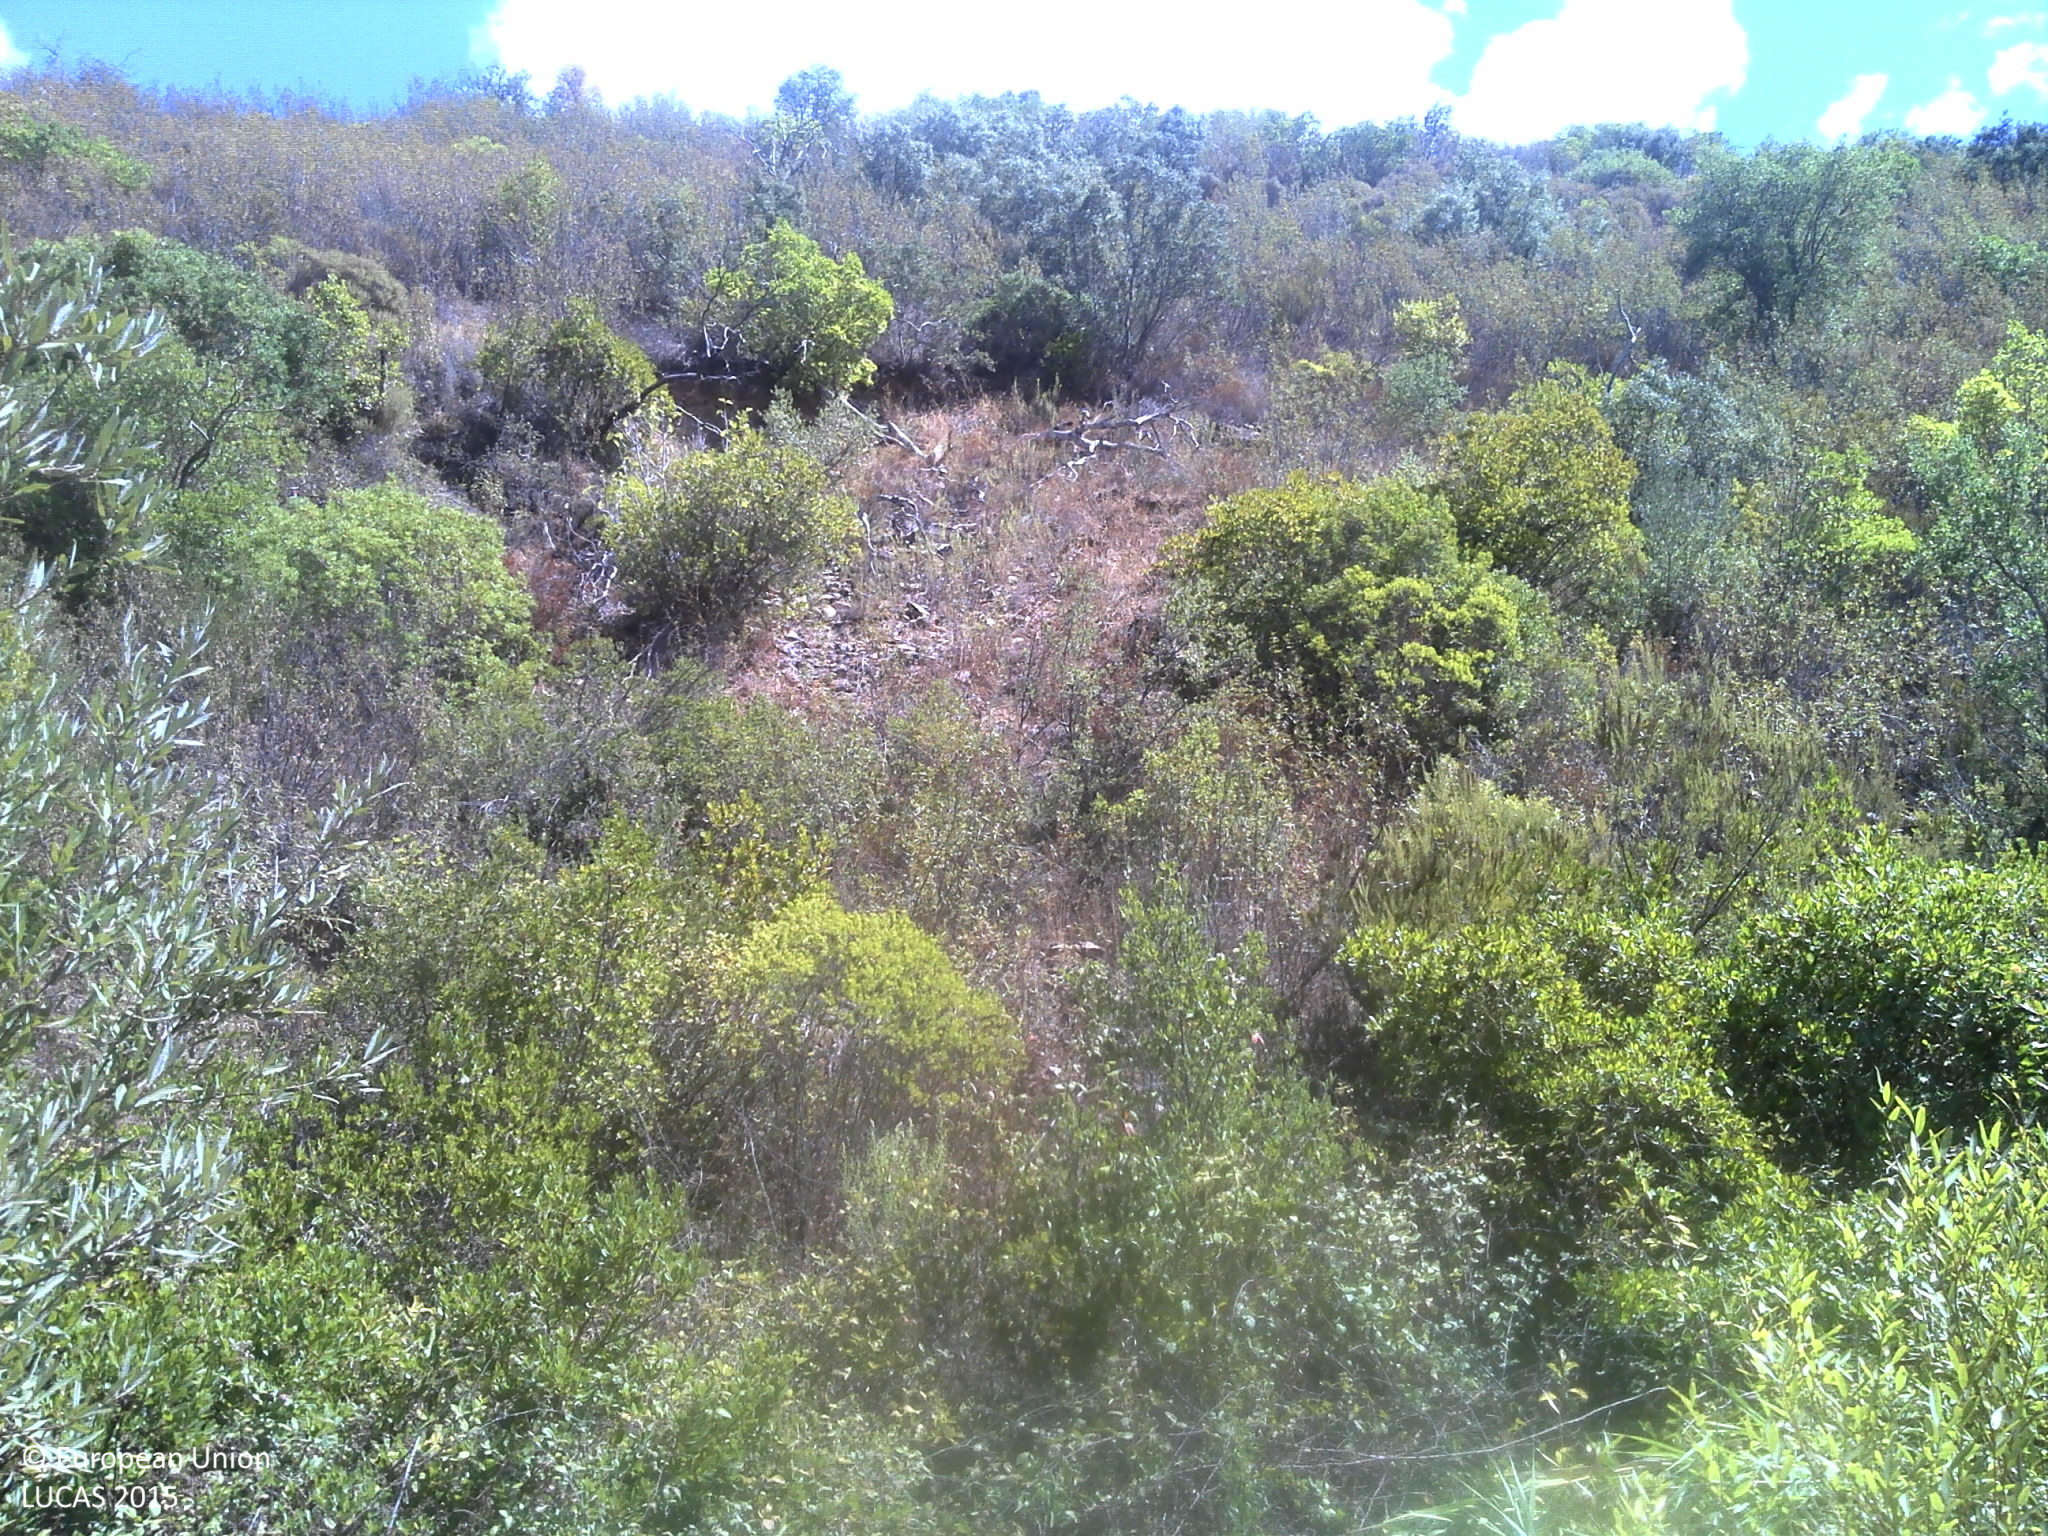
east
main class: Shrubland
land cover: Shrubland with sparse tree cover
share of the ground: > 75 %
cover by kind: shrubs 75 %, unconsolidated bare surface 20 %, broadleaved forest trees 5 %
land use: Abandoned areas
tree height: < 5 m
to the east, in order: Shrubland with sparse tree cover; Tracks; Shrubland without tree cover; Tracks; Grassland with sparse tree/shrub cover; Shrubland with sparse tree cover; Tracks; Grassland with sparse tree/shrub cover; Tracks; Grassland with sparse tree/shrub cover
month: September
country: PT
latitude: 37.3093
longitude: -8.1977
